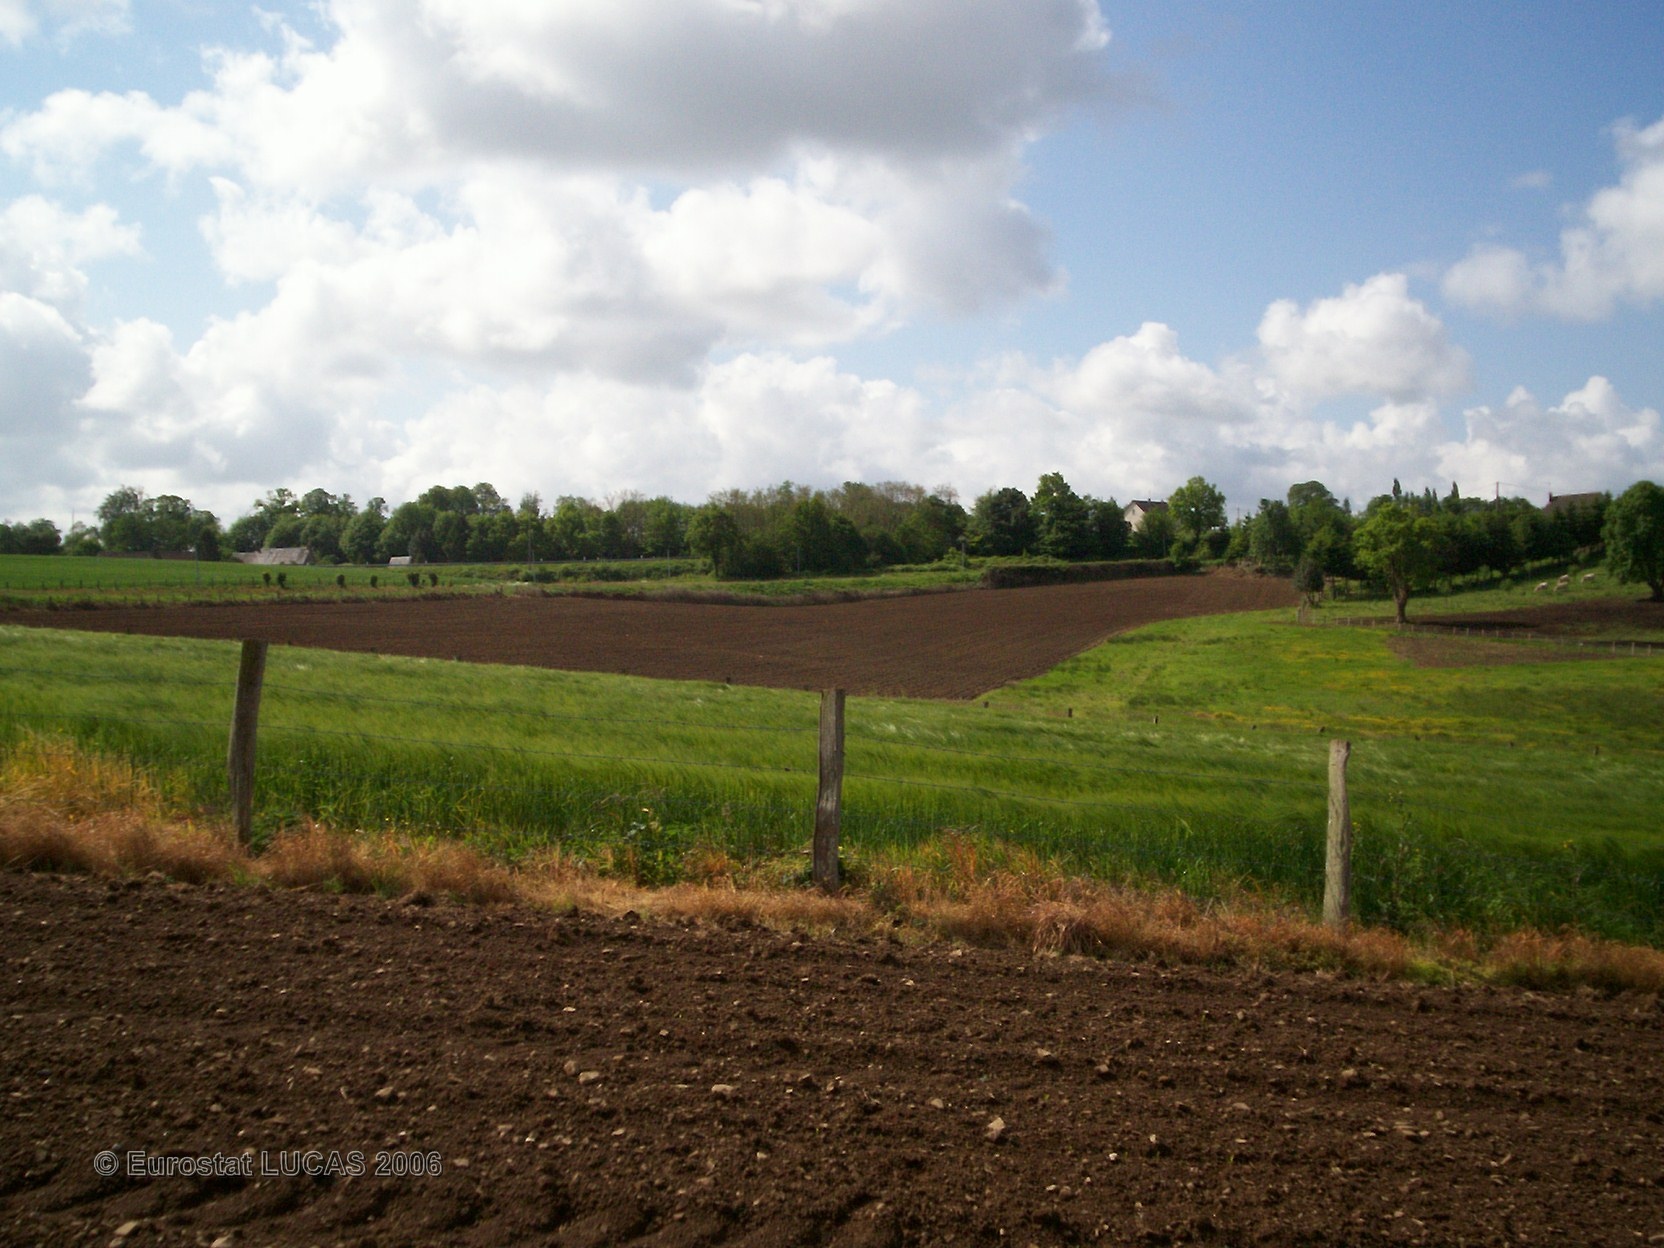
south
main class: Cropland
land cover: Maize
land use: Agriculture (excluding fallow land and kitchen gardens)
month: May
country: FR
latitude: 48.5516
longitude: -0.7265
